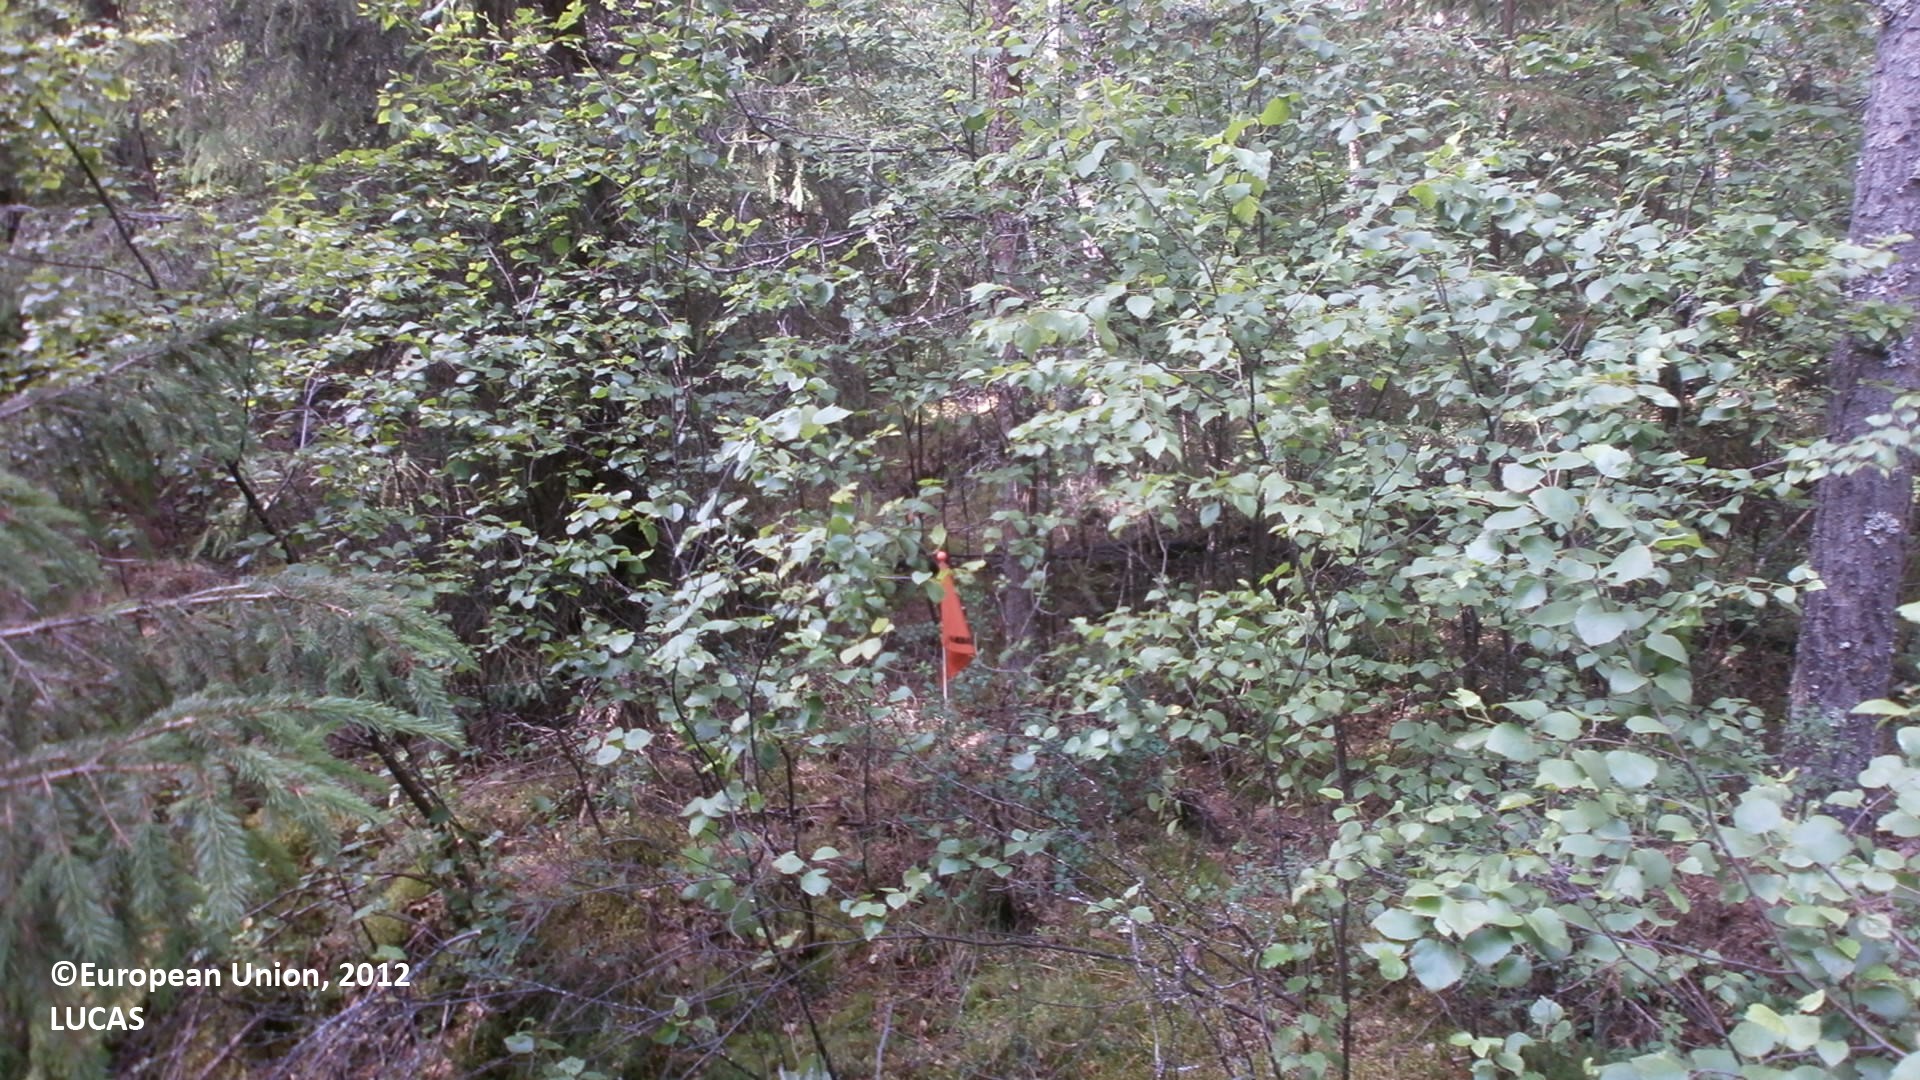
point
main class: Woodland
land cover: Other mixed woodland
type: boreal forest
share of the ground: 50 - 75 %
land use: Forestry
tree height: > 5 m
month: July
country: FI
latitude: 63.9956
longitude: 23.9866
